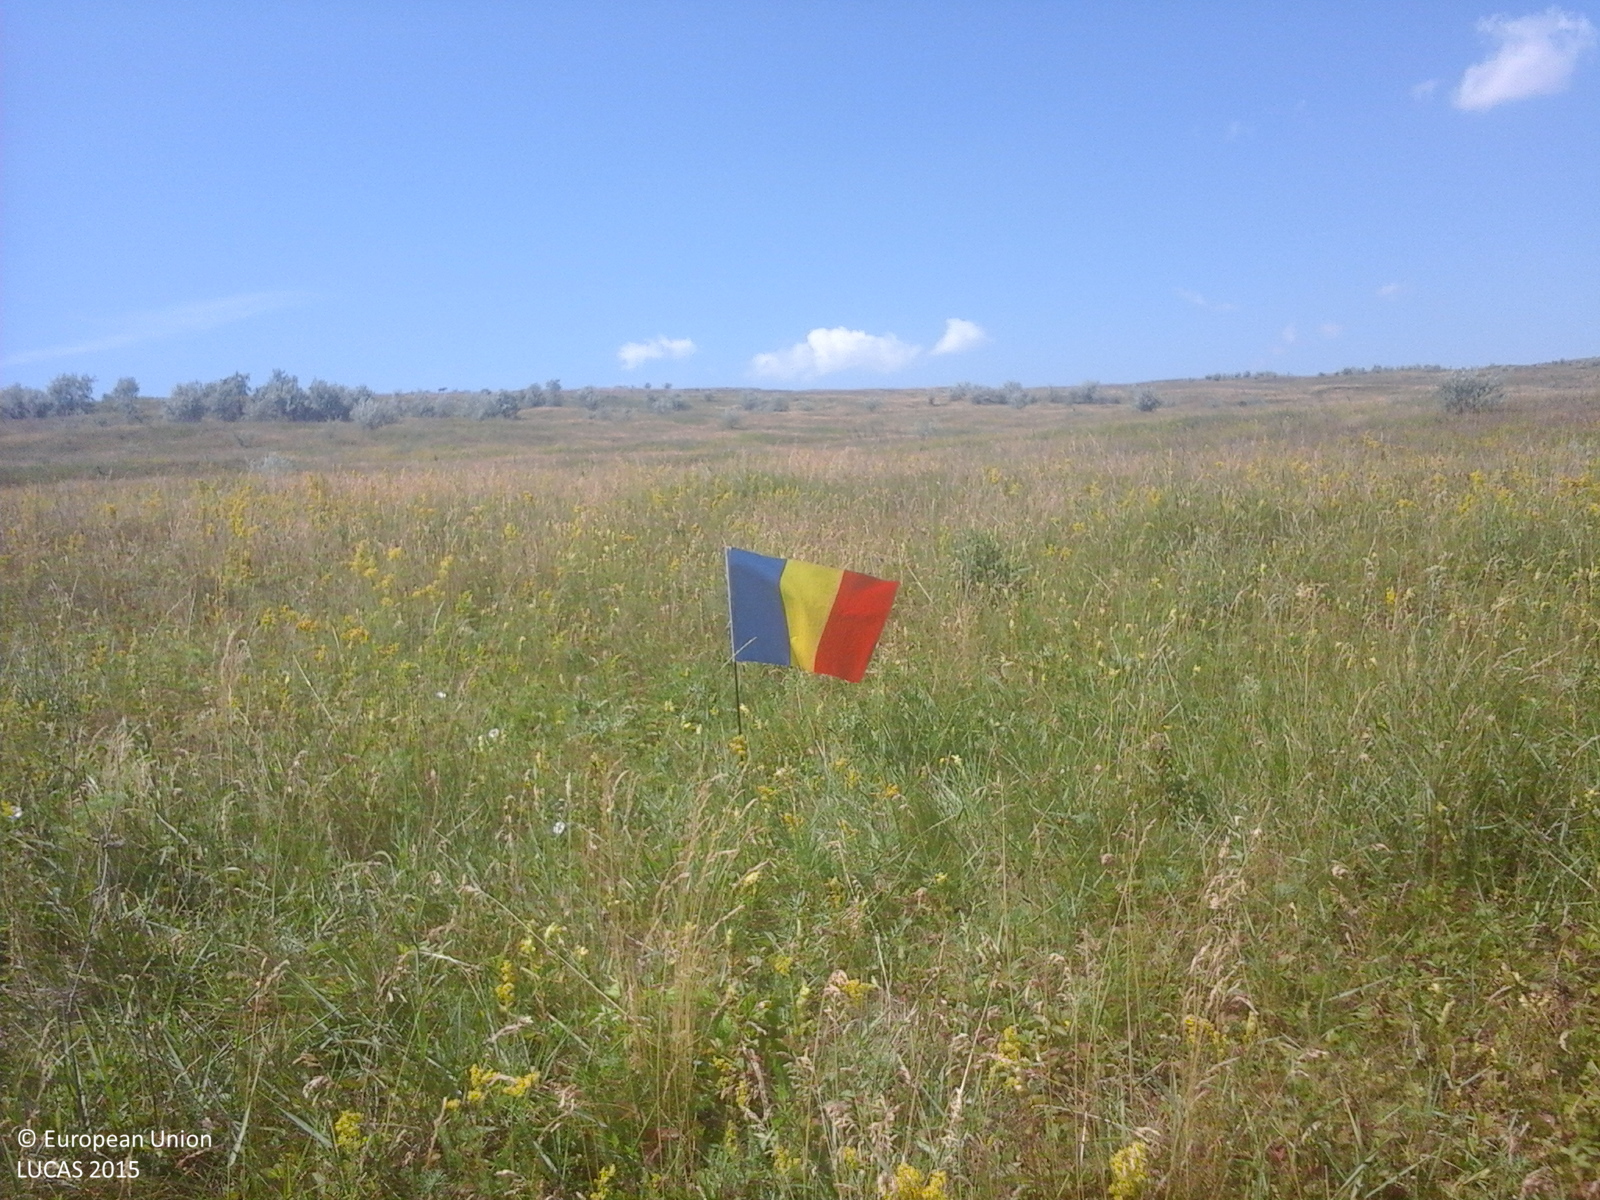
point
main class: Grassland
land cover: Grassland without tree/shrub cover
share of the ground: > 75 %
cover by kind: herbaceous plants 100 %
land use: Agriculture (excluding fallow land and kitchen gardens)
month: June
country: RO
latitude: 47.7954
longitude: 26.8552
